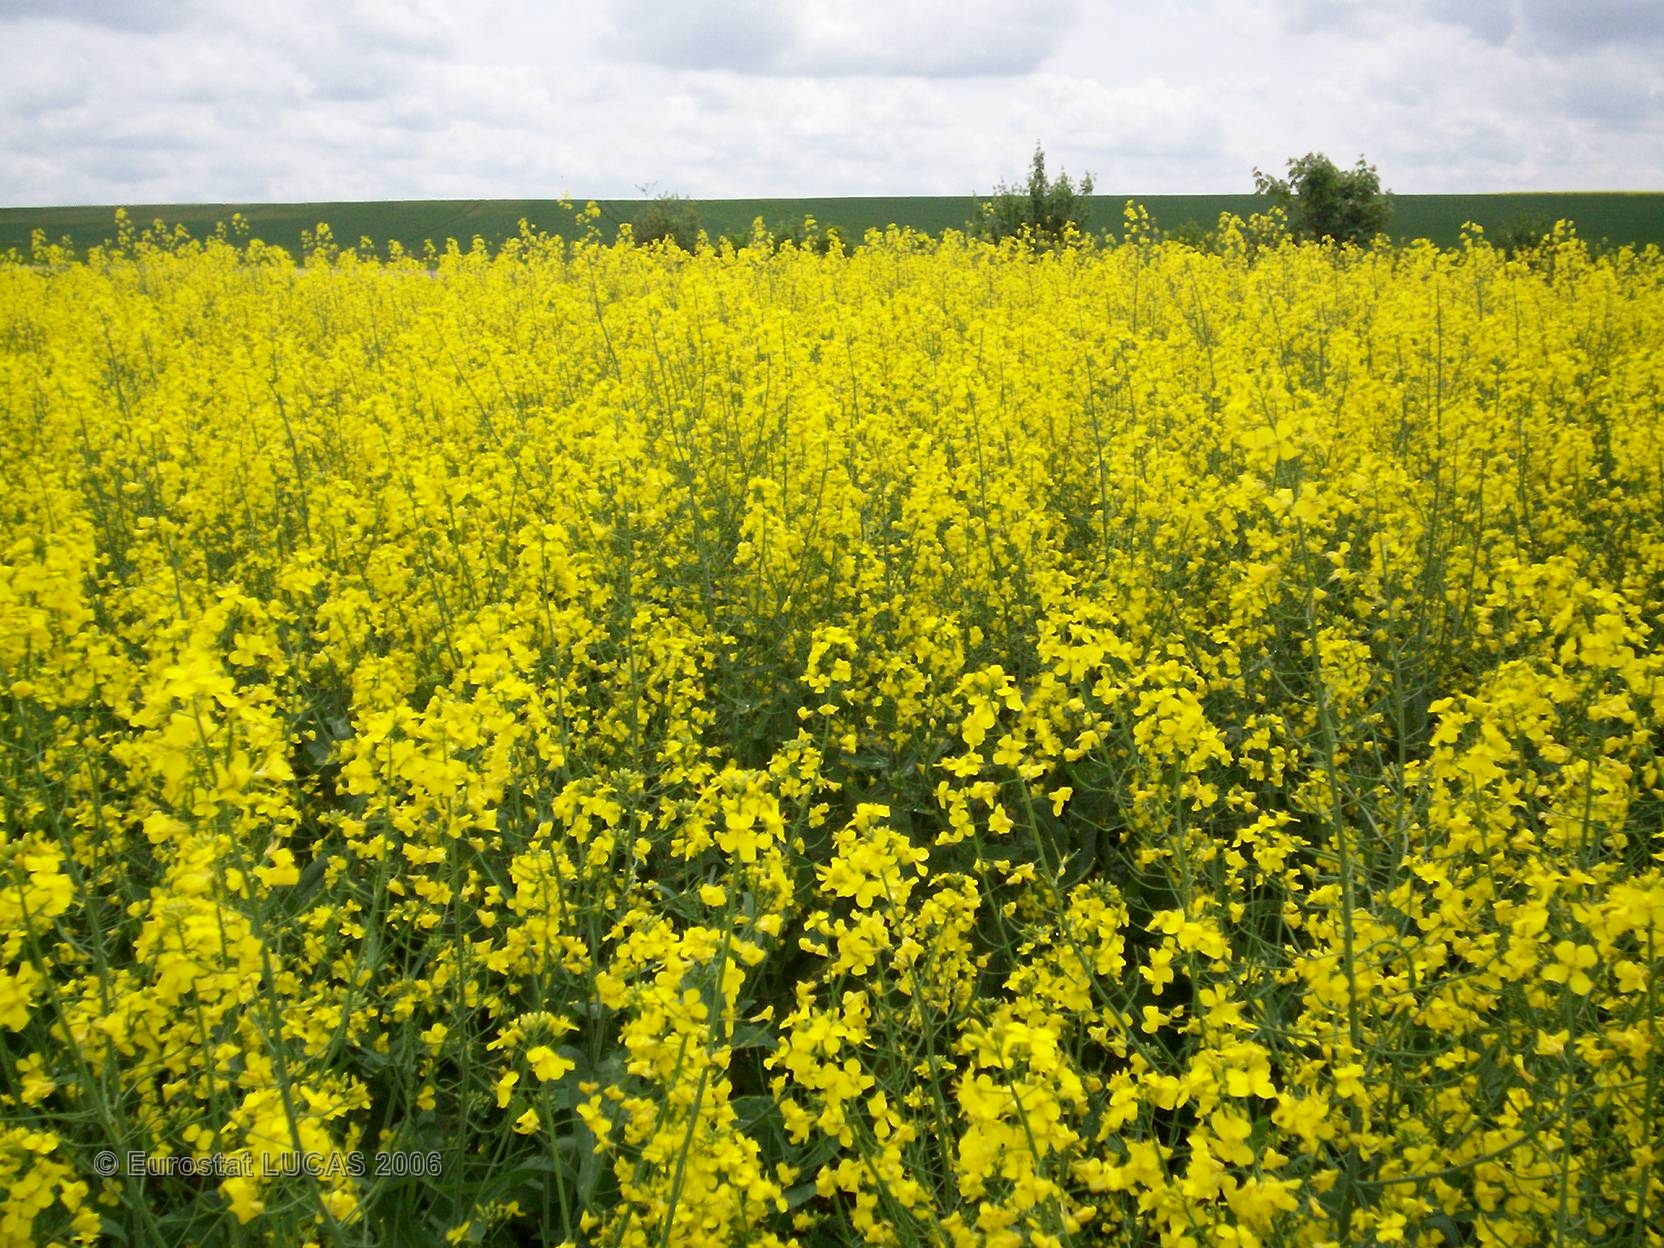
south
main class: Cropland
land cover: Rape and turnip rape
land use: Agriculture (excluding fallow land and kitchen gardens)
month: May
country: FR
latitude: 49.1212
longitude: 5.9299
